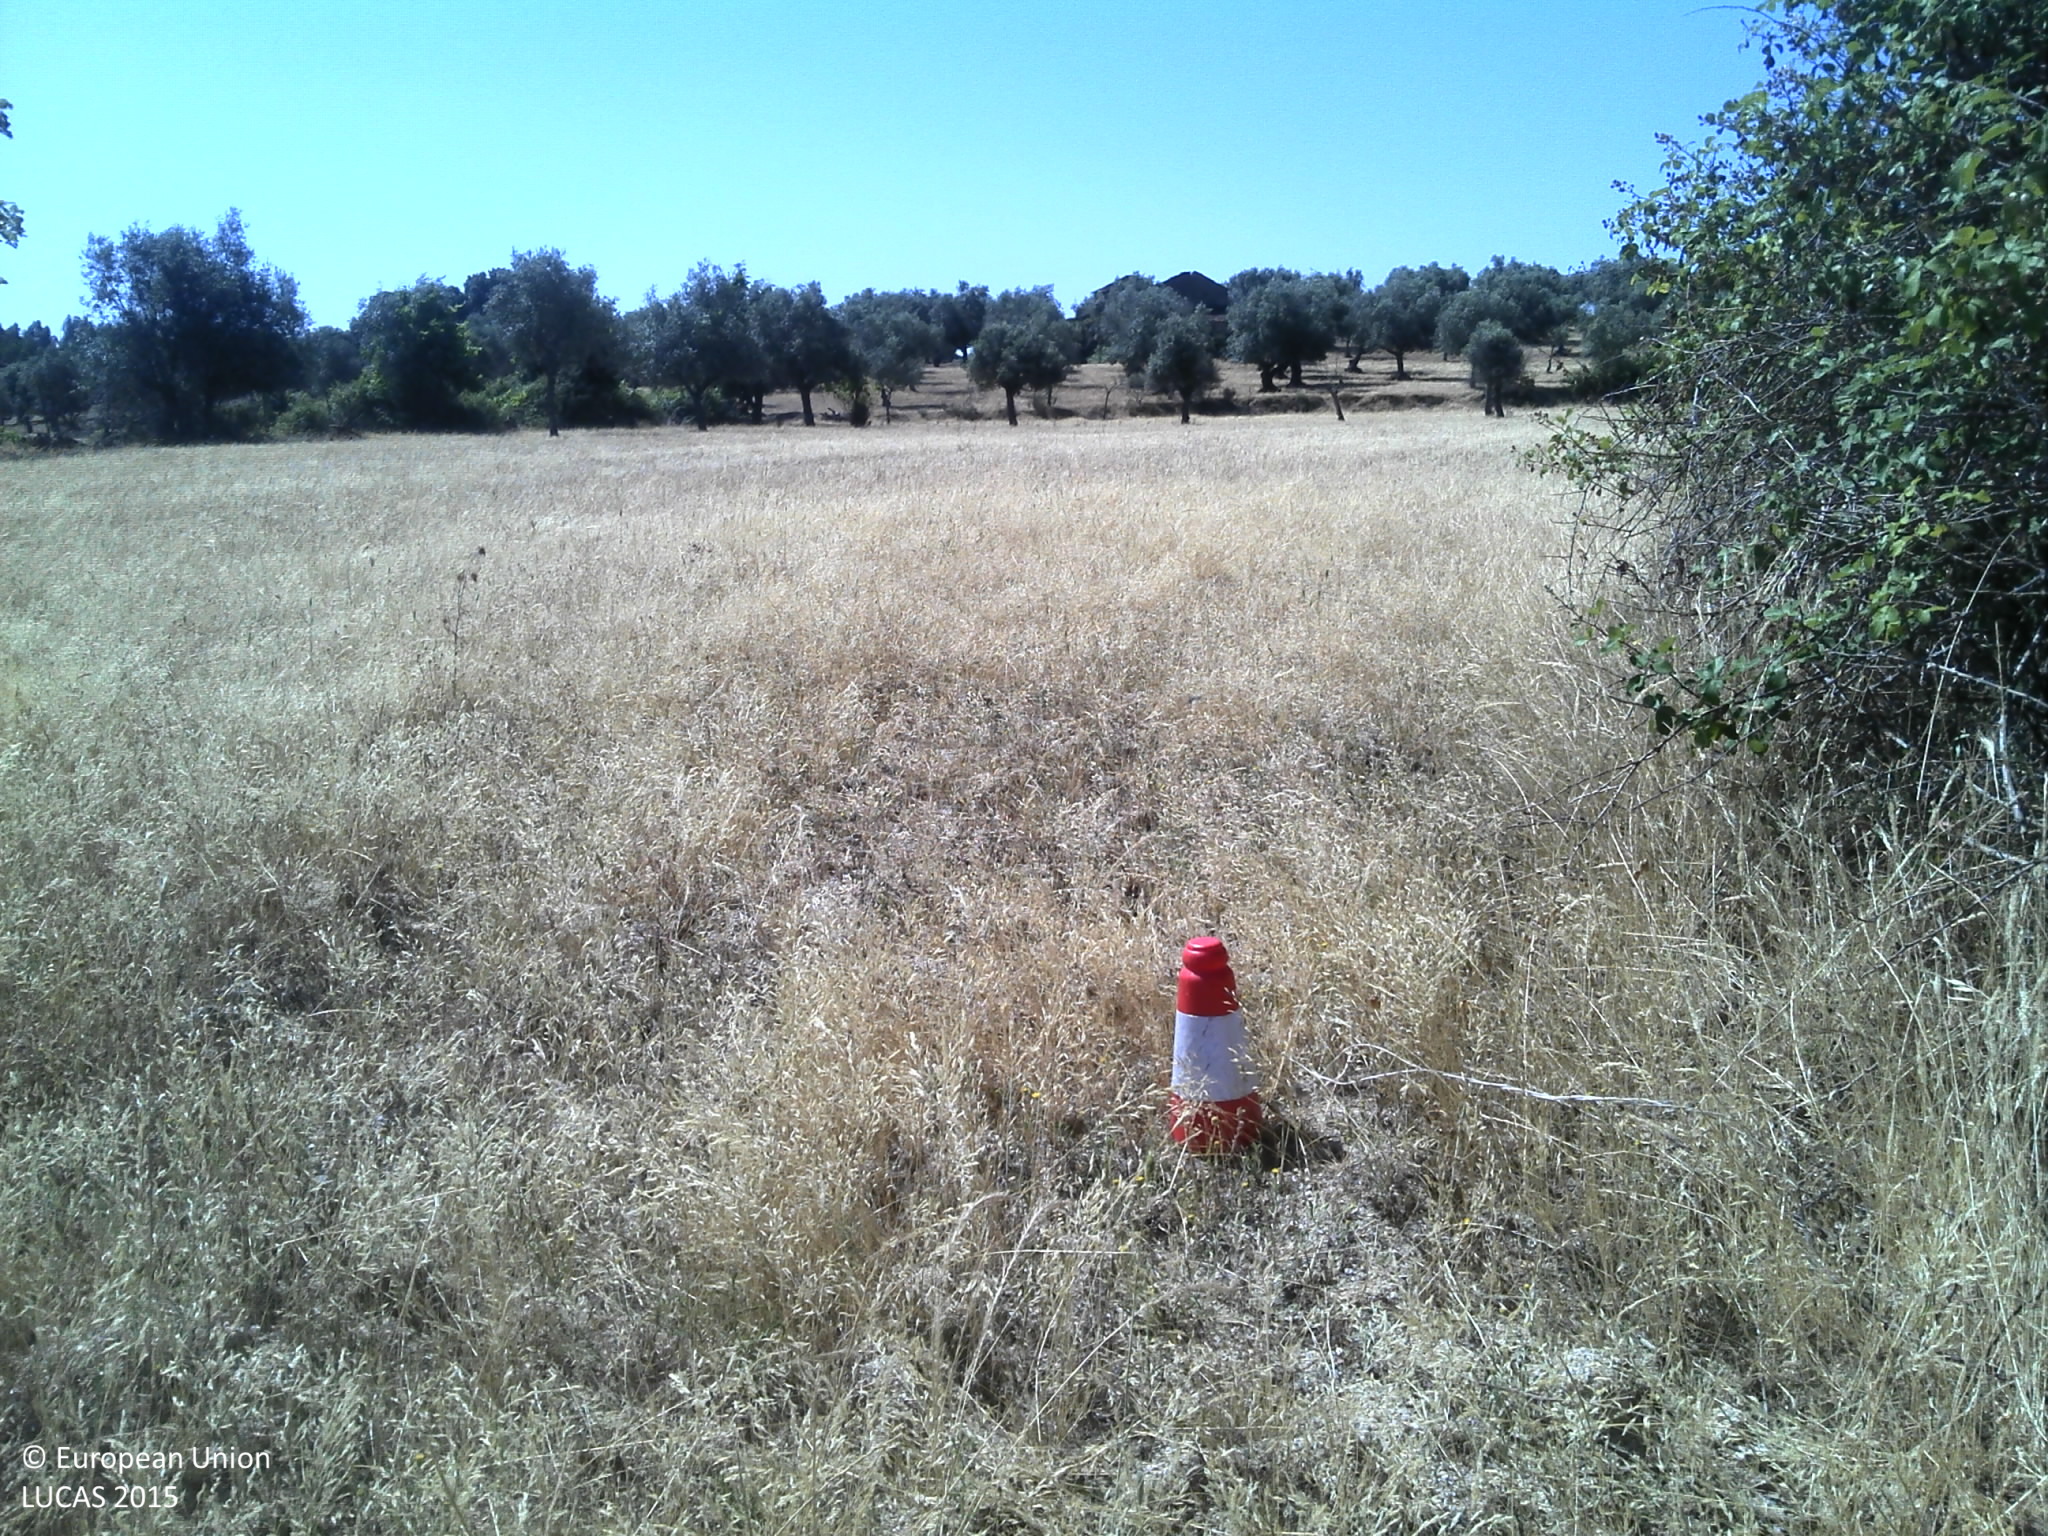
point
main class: Grassland
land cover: Spontaneously vegetated surfaces
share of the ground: 50 - 75 %
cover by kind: herbaceous plants 60 %, unconsolidated bare surface 40 %
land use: Fallow land
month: June
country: PT
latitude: 40.0346
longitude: -7.3619
